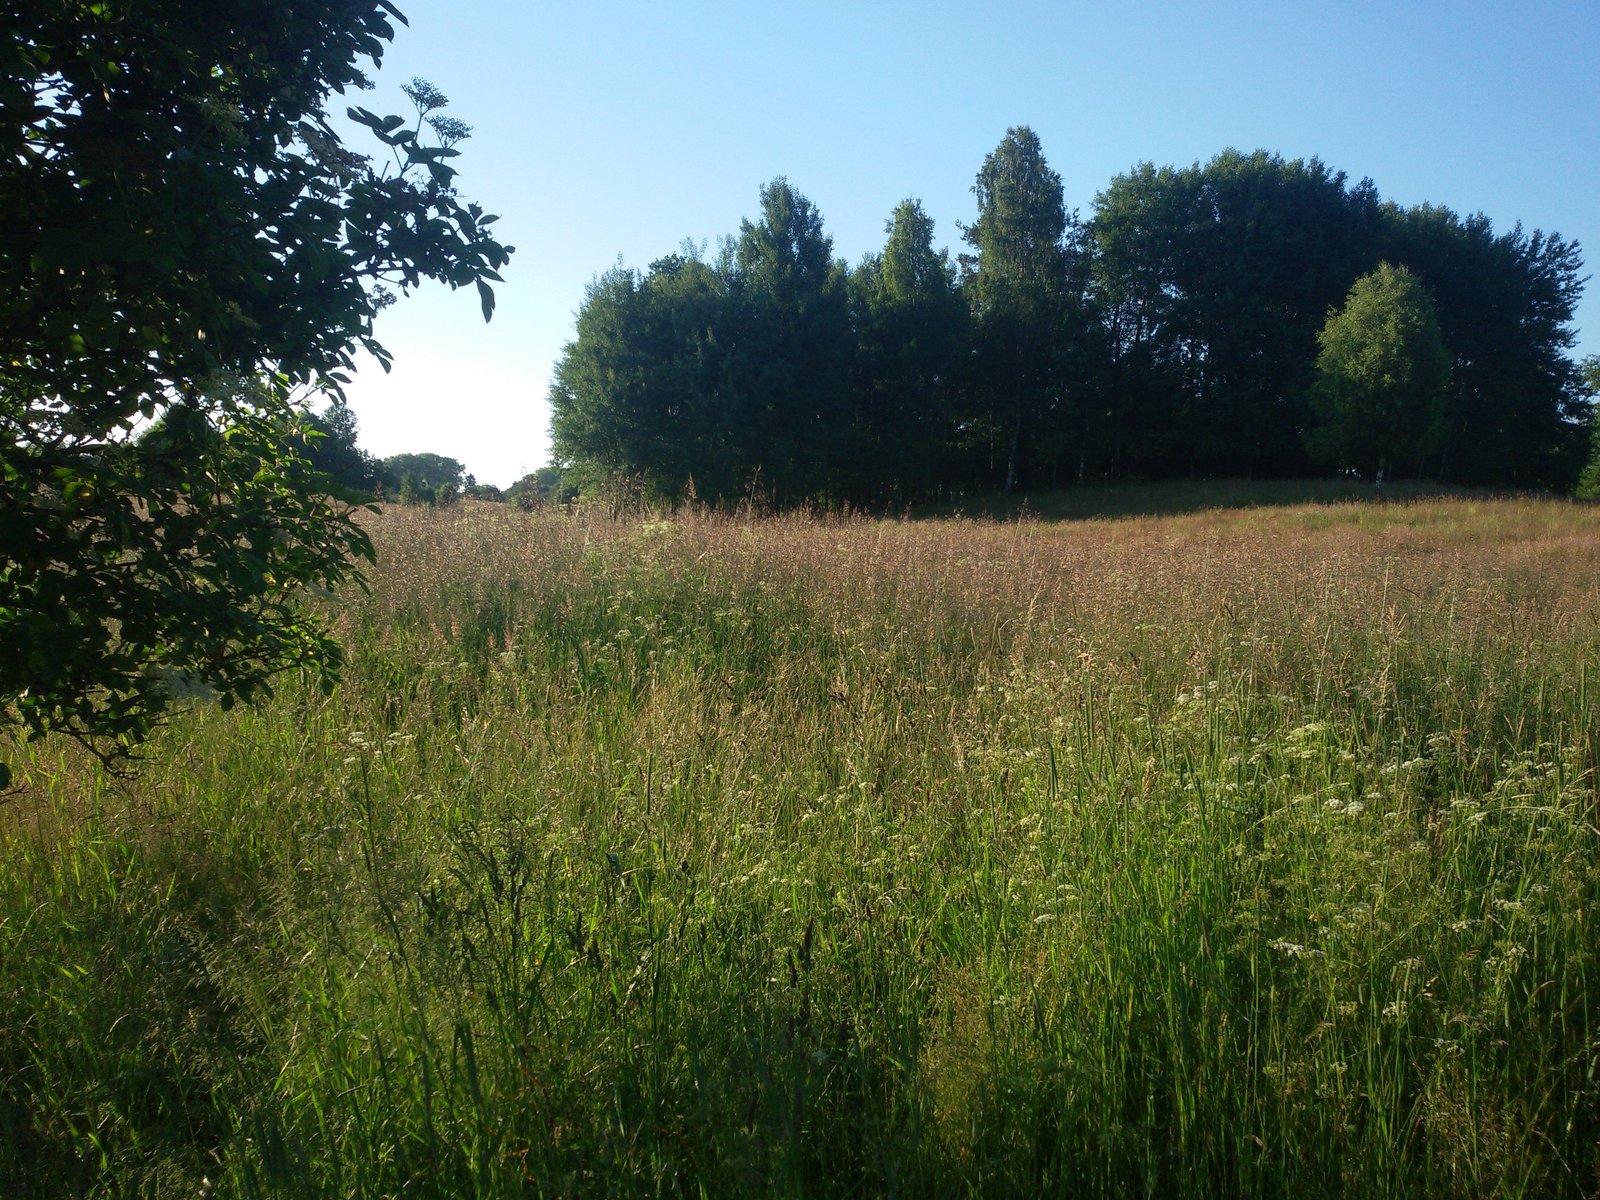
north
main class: Grassland
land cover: Grassland with sparse tree/shrub cover
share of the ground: > 75 %
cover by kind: herbaceous plants 95 %, broadleaved forest trees 5 %
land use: Agriculture (excluding fallow land and kitchen gardens)
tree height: > 5 m
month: July
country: PL
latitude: 53.6626
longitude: 16.1039
